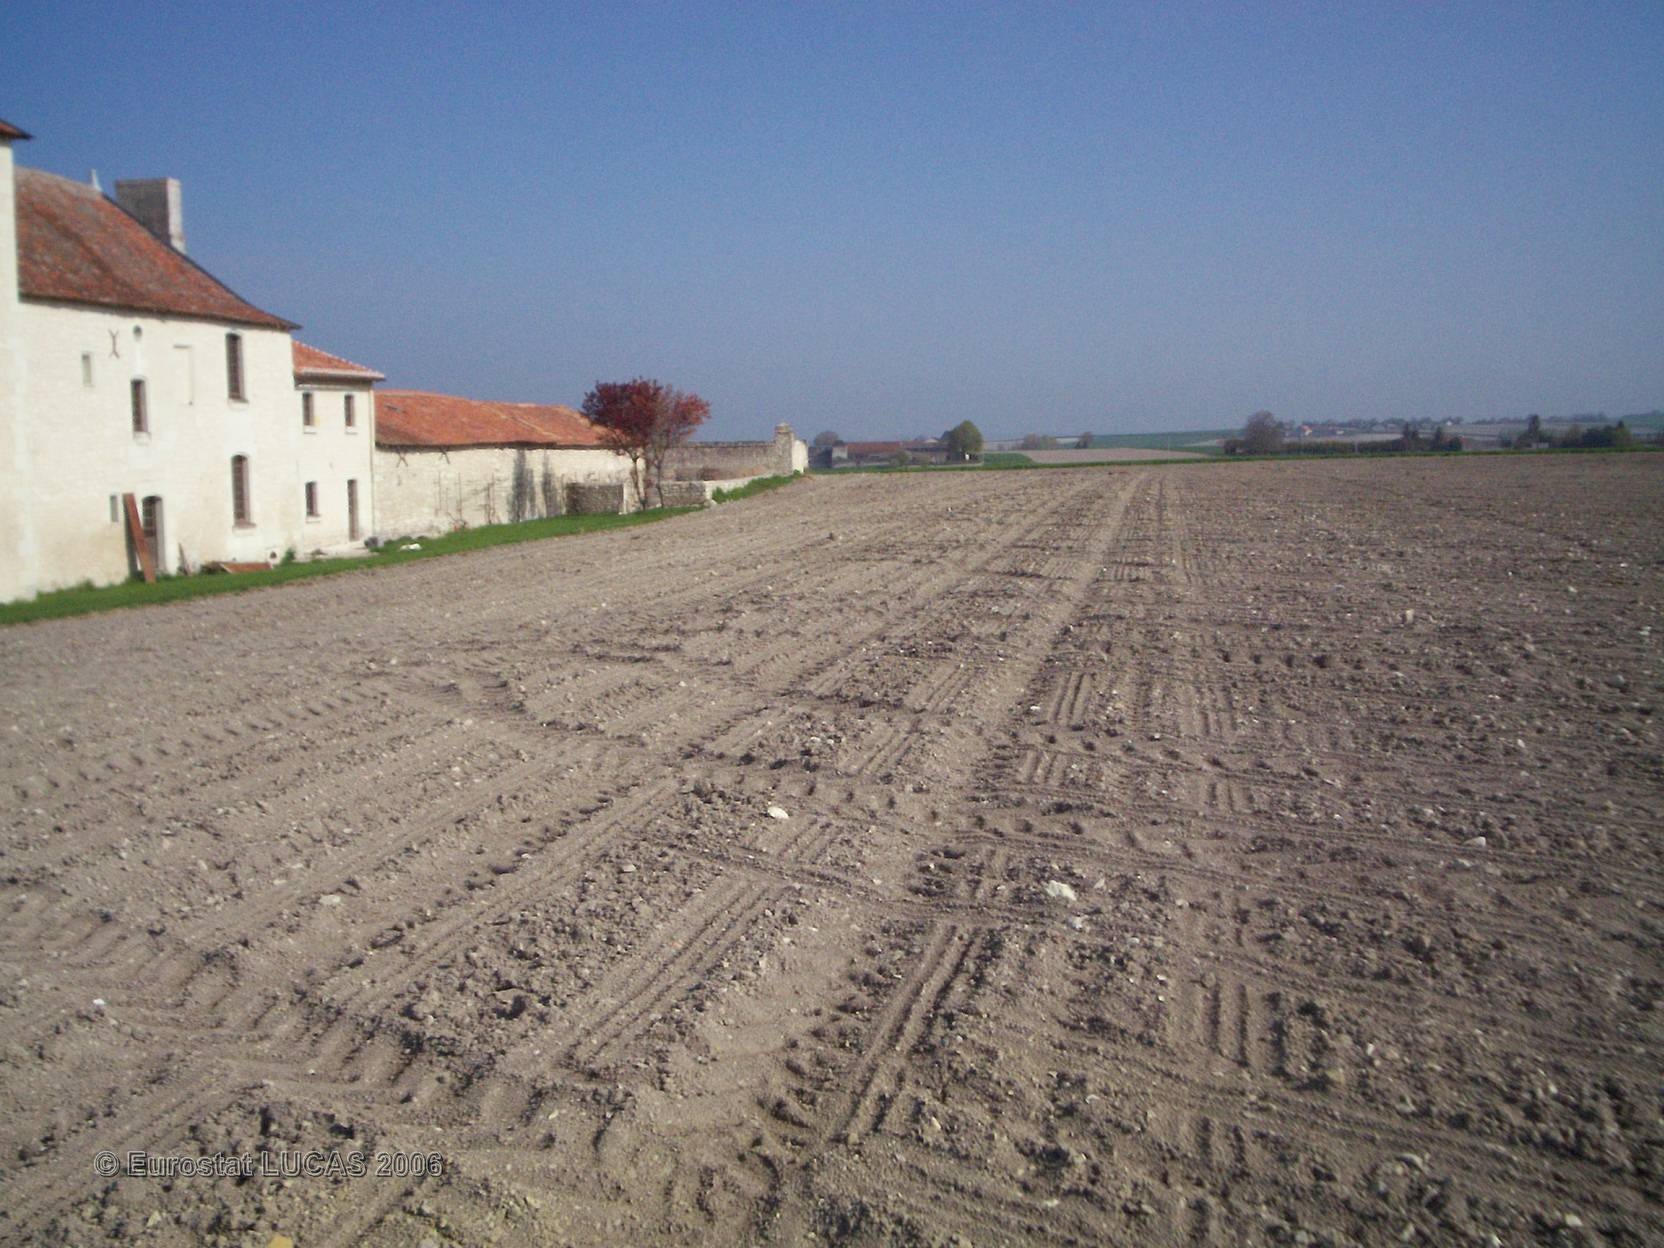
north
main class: Bare land
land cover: Bare land
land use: Agriculture (excluding fallow land and kitchen gardens)
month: April
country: FR
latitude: 46.8807
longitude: 0.4143
